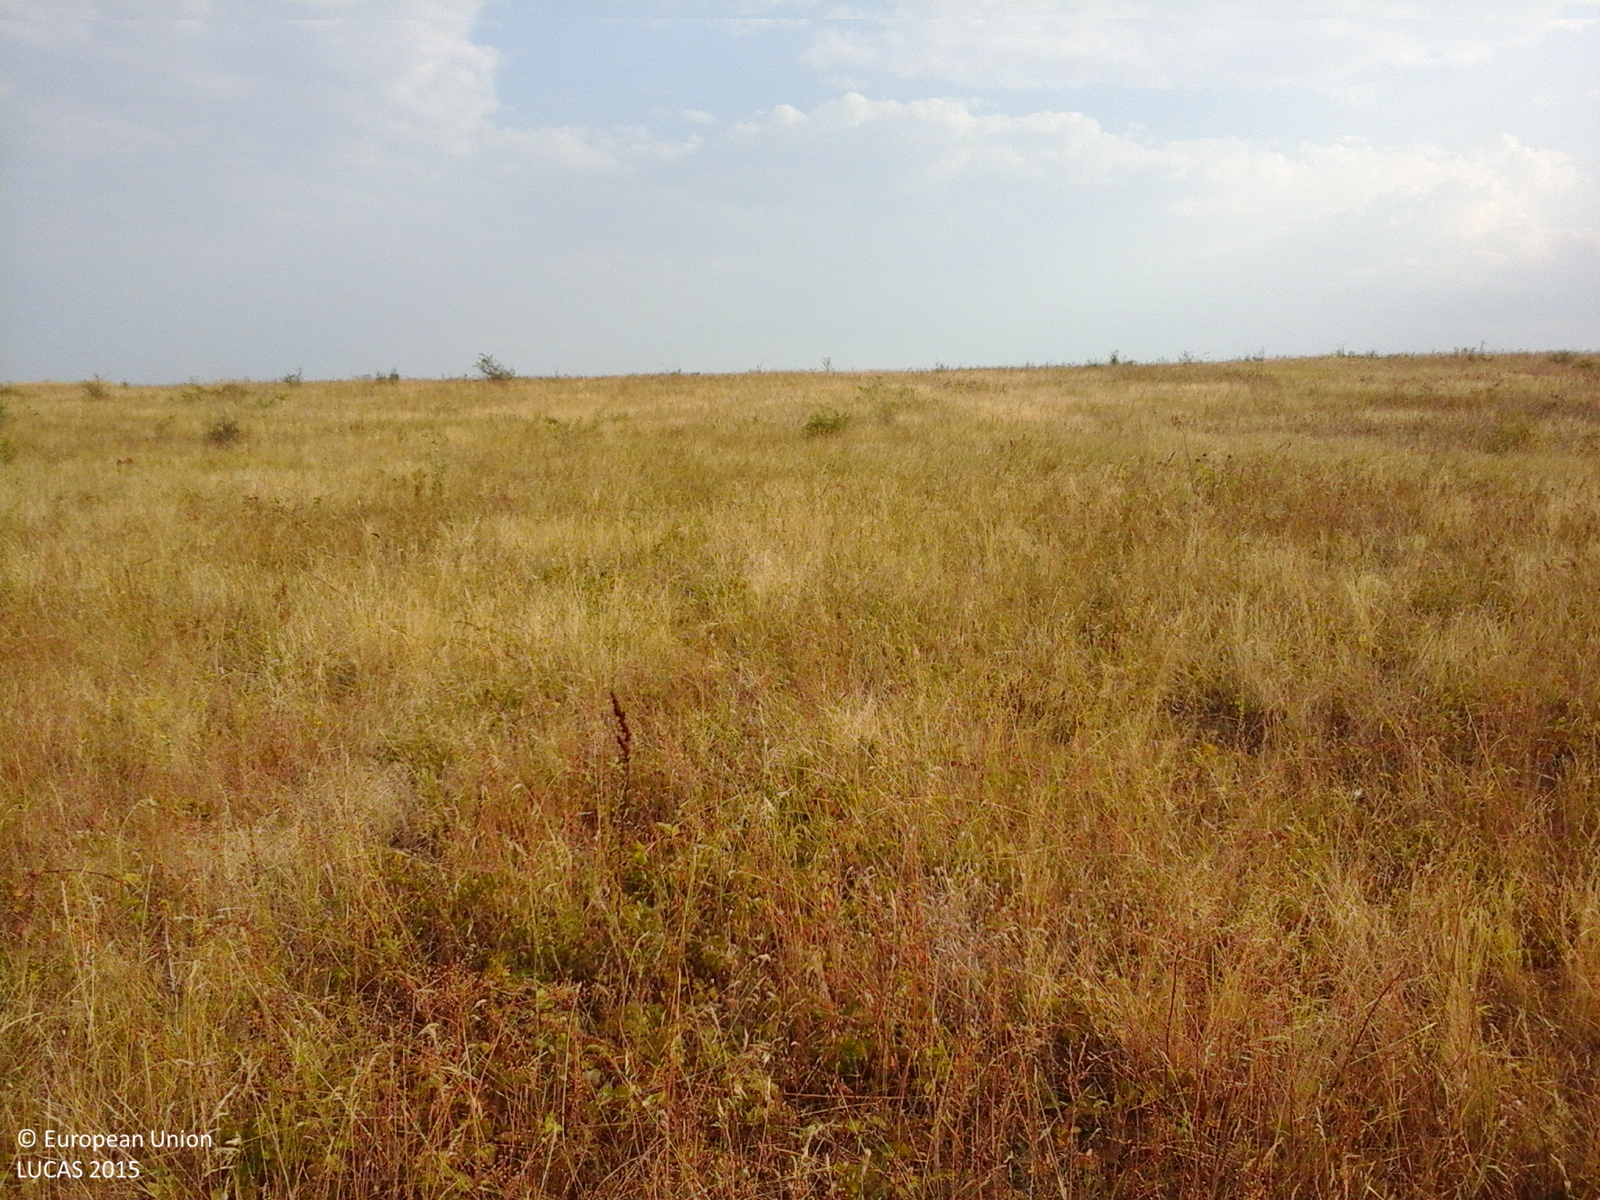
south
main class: Grassland
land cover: Grassland without tree/shrub cover
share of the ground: > 75 %
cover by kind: herbaceous plants 100 %
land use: Agriculture (excluding fallow land and kitchen gardens)
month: August
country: RO
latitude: 44.4769
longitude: 23.0071
